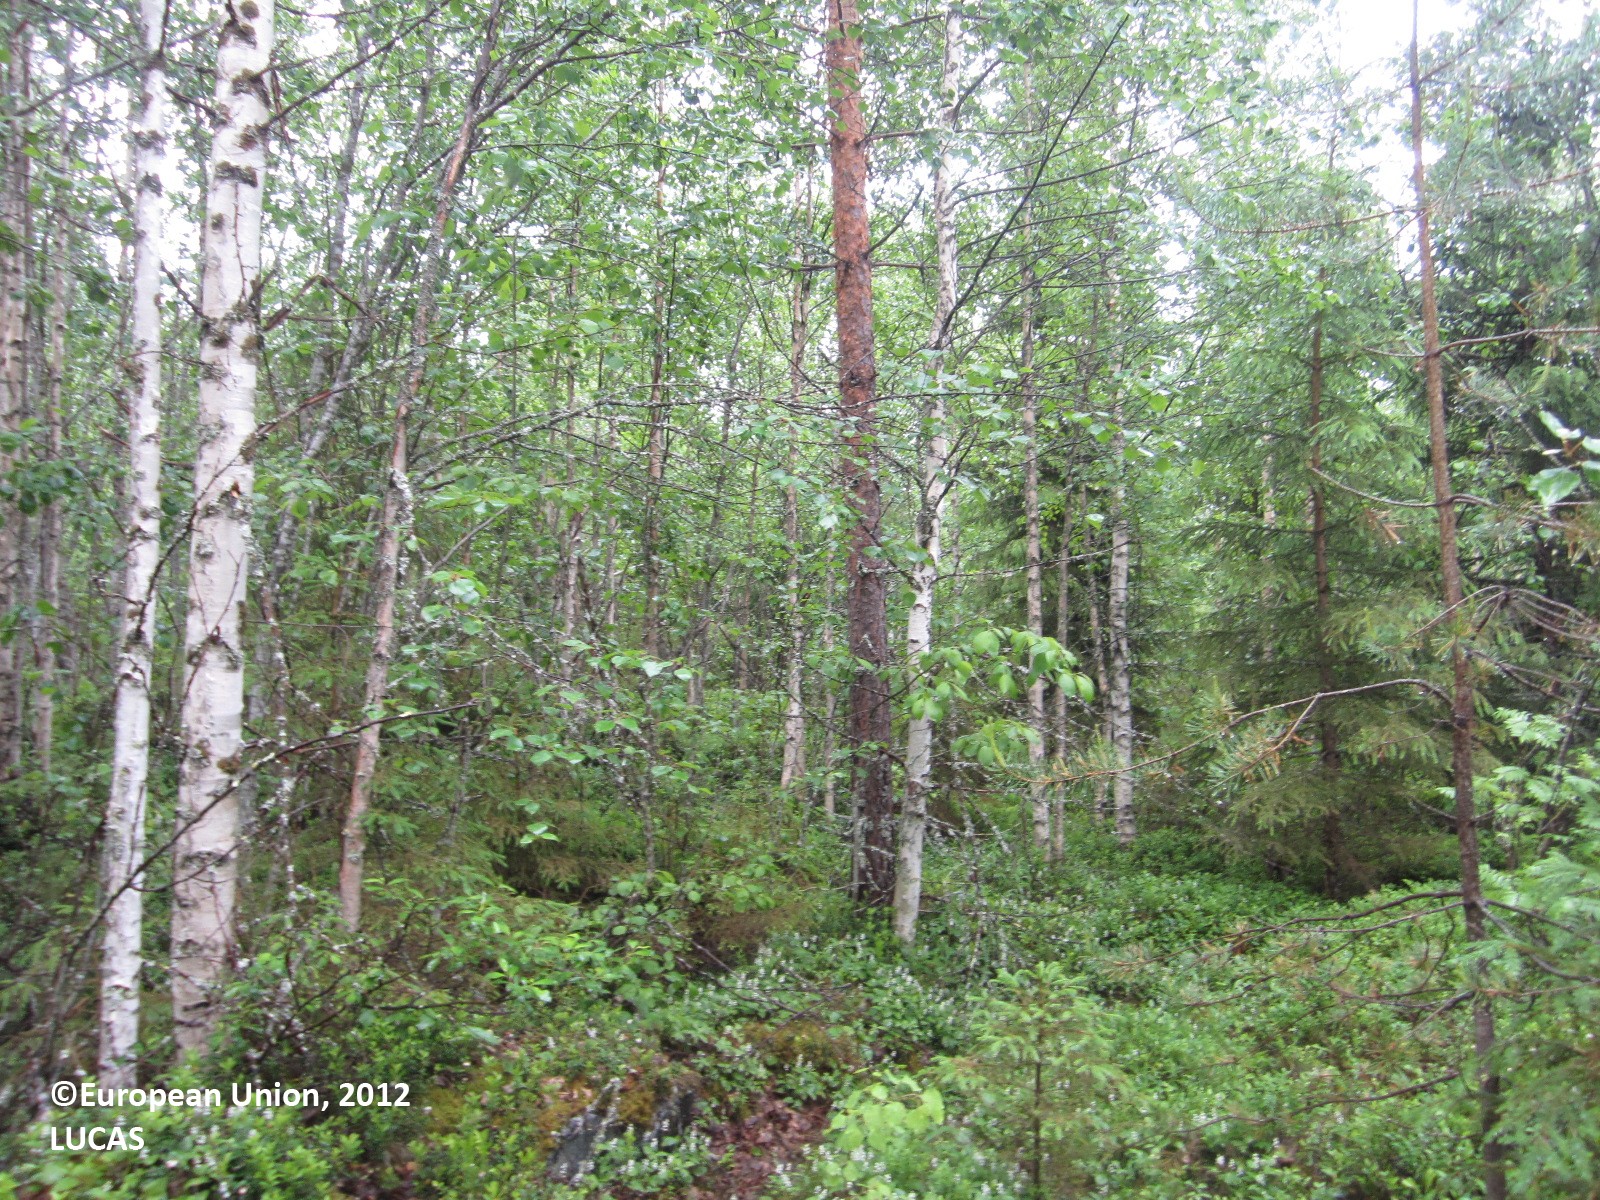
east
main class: Woodland
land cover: Pine dominated mixed woodland
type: boreal forest
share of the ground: > 75 %
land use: Forestry
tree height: > 5 m
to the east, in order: Pine dominated mixed woodland; Ditches and canals; Pine dominated mixed woodland; Ditches and canals; Pine dominated mixed woodland; Spruce dominated mixed woodland; Ditches and canals; Spruce dominated mixed woodland; Ditches and canals; Spruce dominated mixed woodland
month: June
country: FI
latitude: 64.5961
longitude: 29.3211
